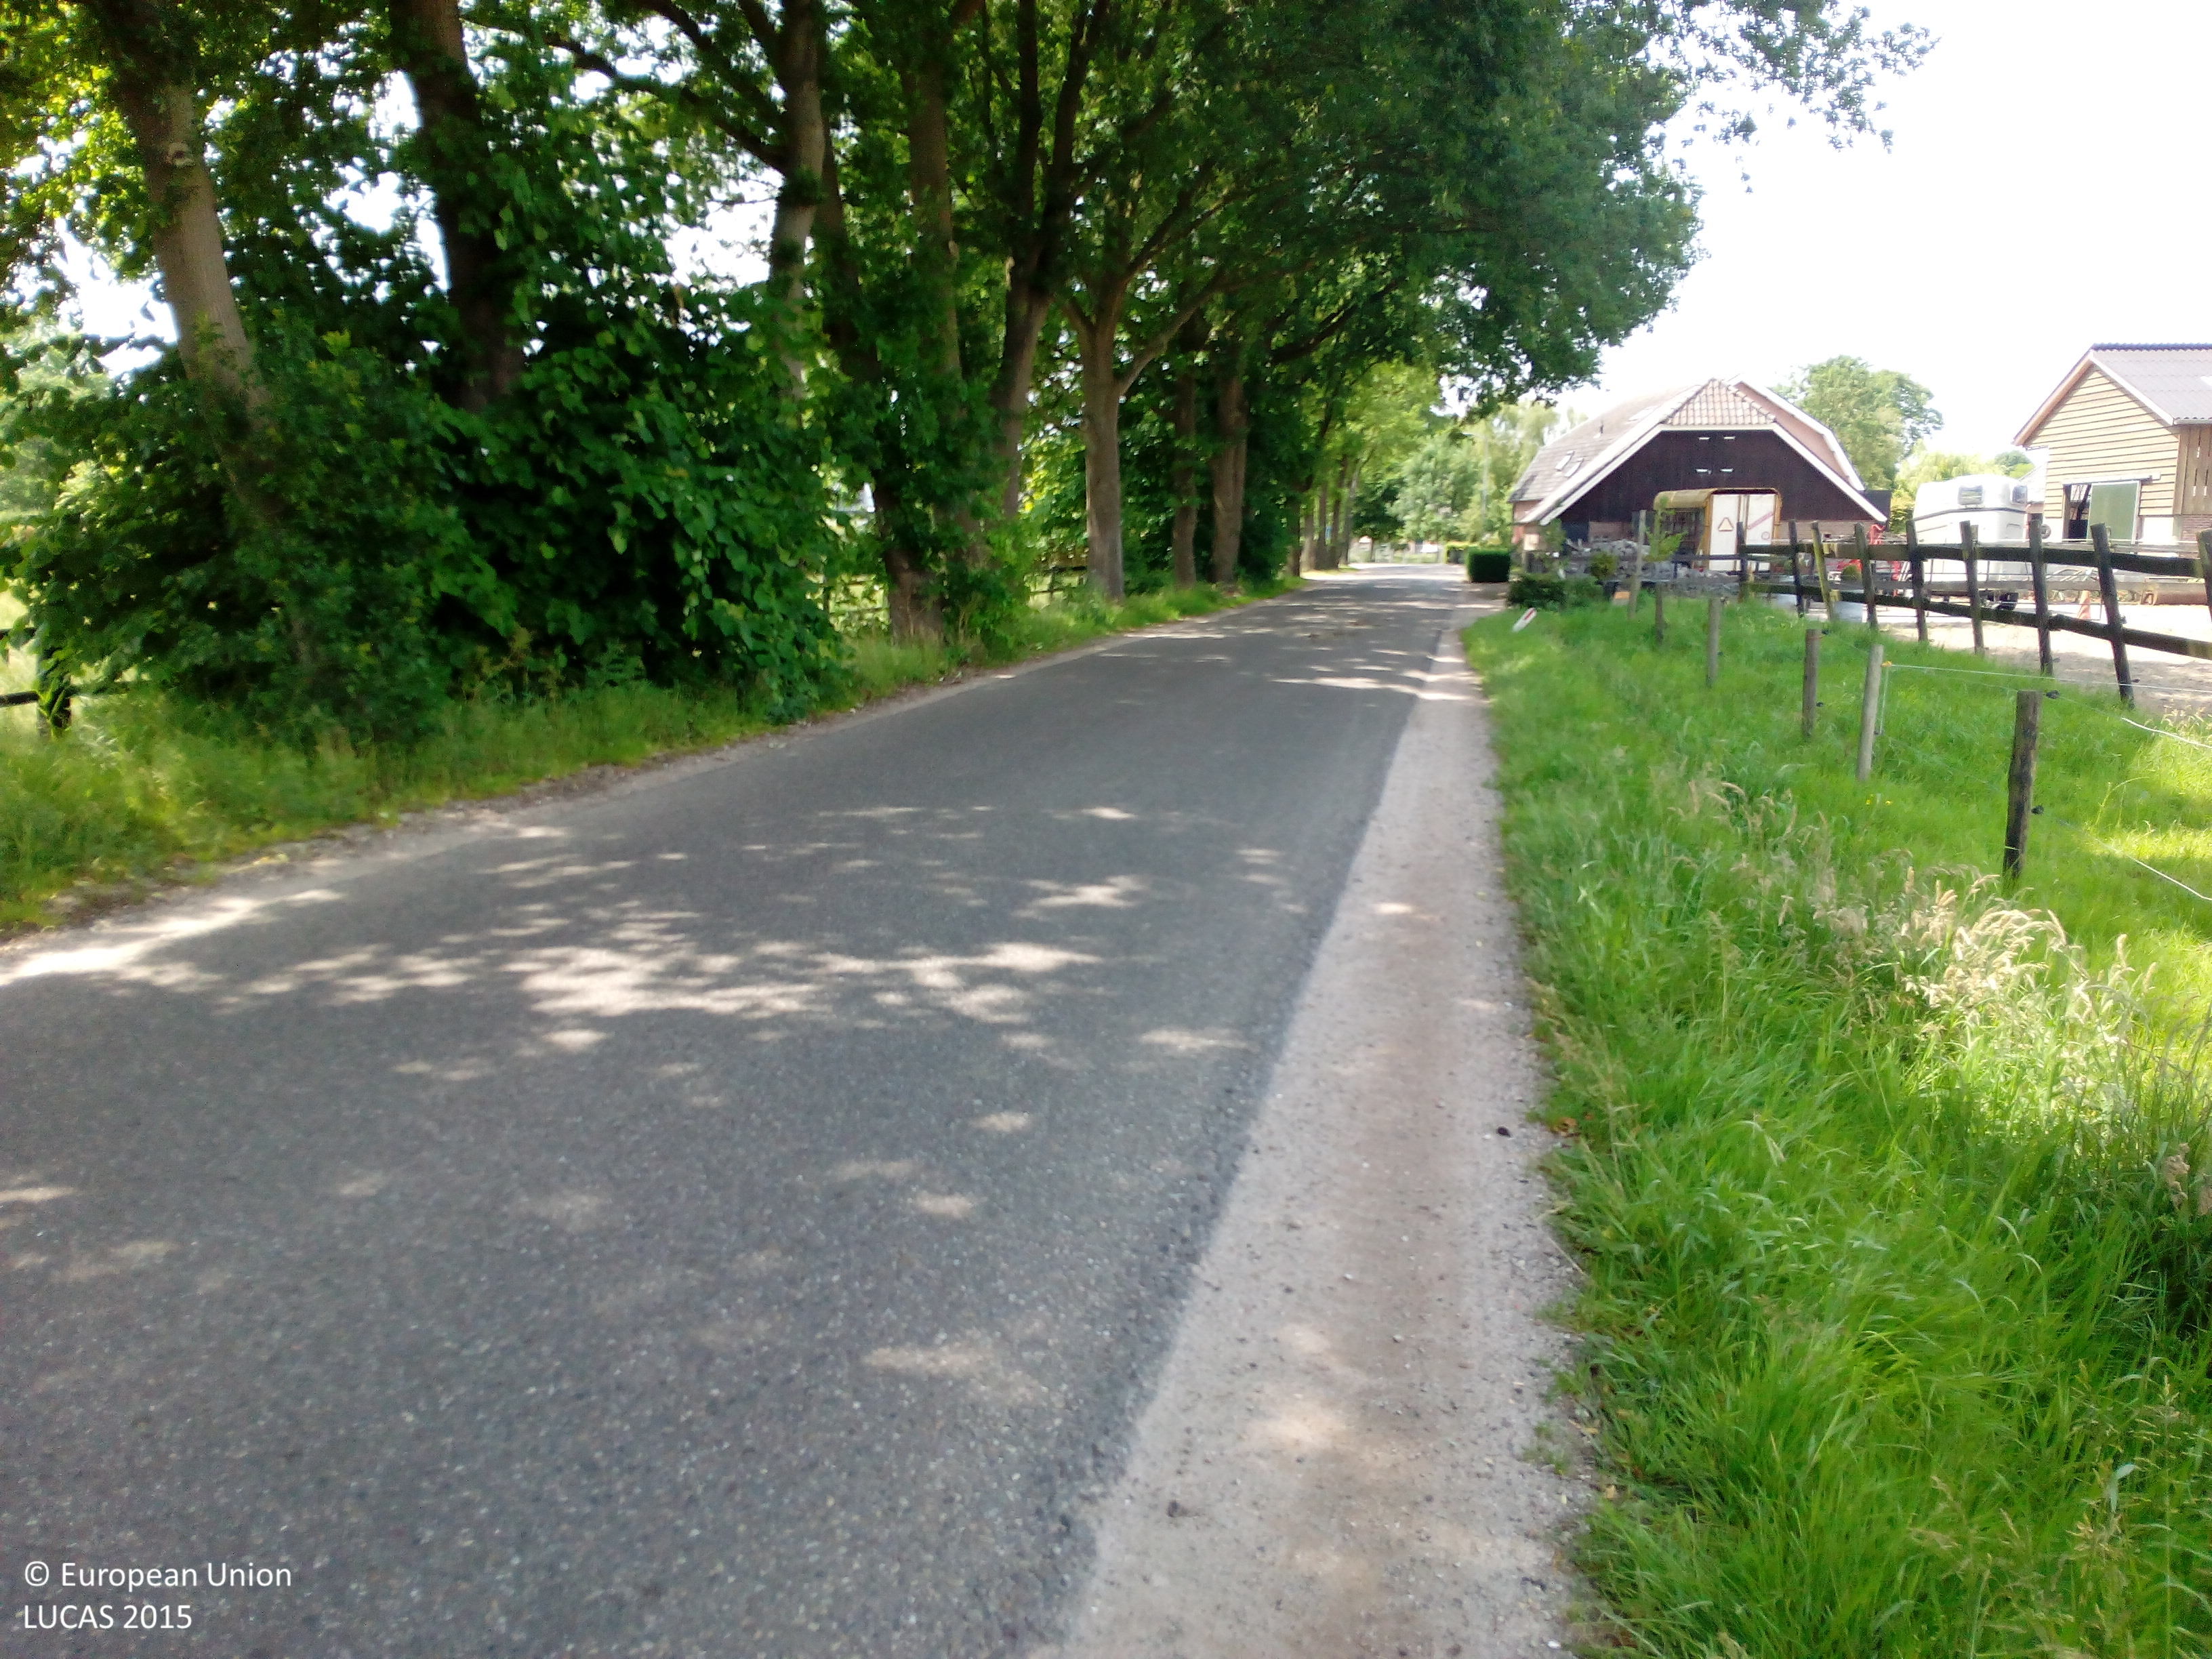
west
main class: Grassland
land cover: Grassland without tree/shrub cover
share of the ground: > 75 %
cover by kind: herbaceous plants 100 %
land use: Agriculture (excluding fallow land and kitchen gardens)
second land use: Sport
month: June
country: NL
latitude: 52.2204
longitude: 5.5045
